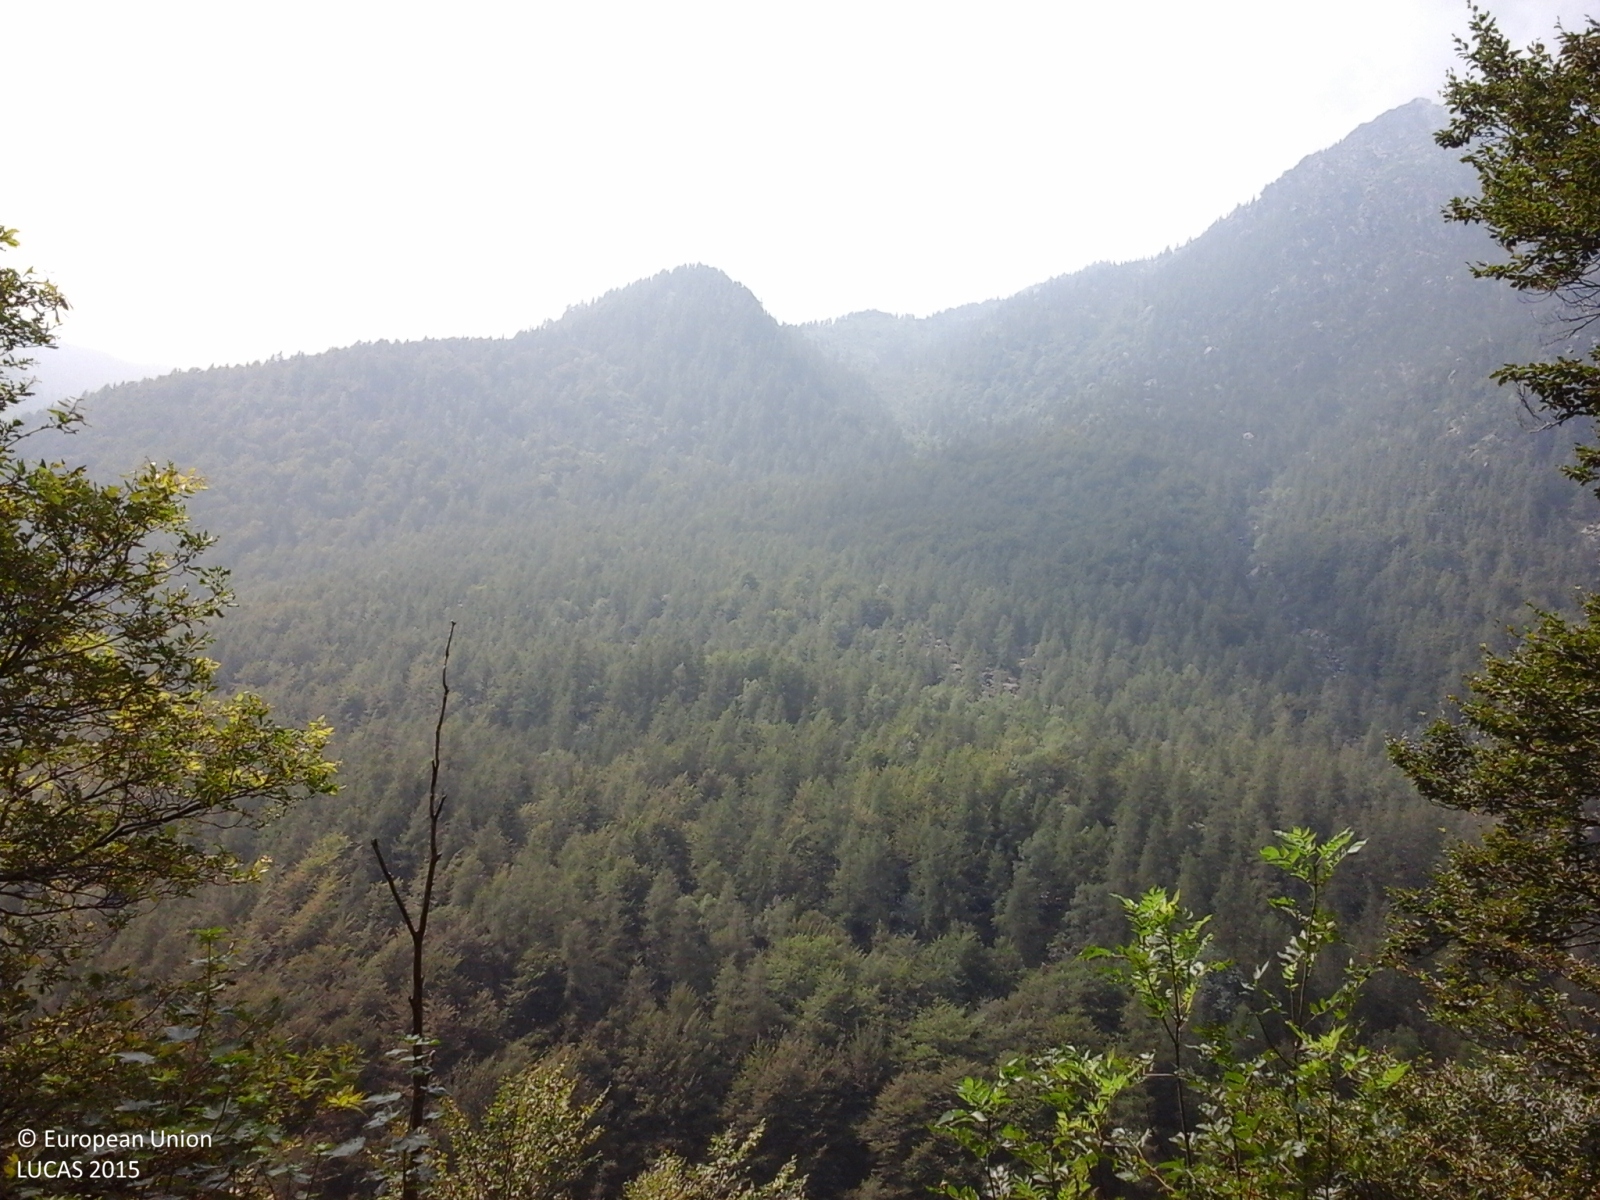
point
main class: Woodland
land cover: Other mixed woodland
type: alpine coniferous forest
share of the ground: > 75 %
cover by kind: coniferous forest trees 60 %, broadleaved forest trees 40 %
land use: Semi-natural and natural areas not in use
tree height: > 5 m
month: July
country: IT
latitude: 45.3073
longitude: 7.2876
